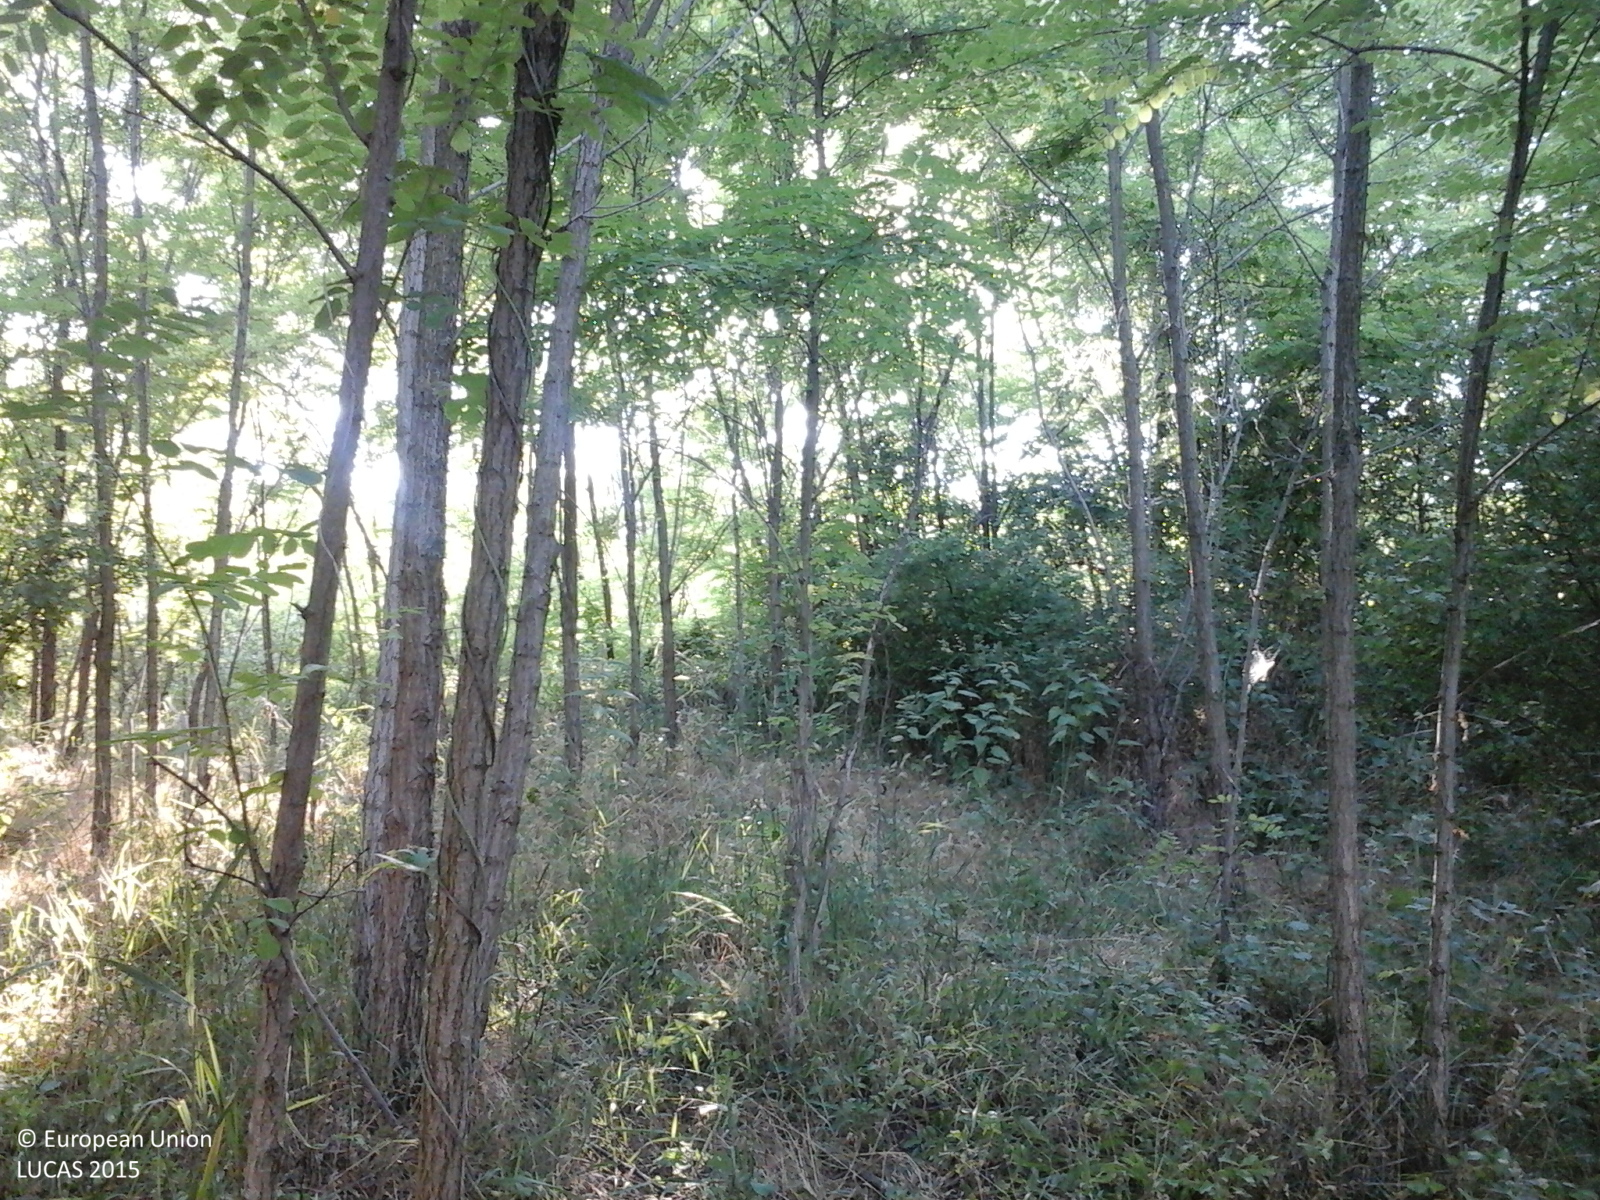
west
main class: Woodland
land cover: Broadleaved woodland
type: mesophytic deciduous forest
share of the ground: > 75 %
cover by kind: broadleaved forest trees 100 %
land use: Forestry
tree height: > 5 m
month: June
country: RO
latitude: 46.7923
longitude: 28.1469
